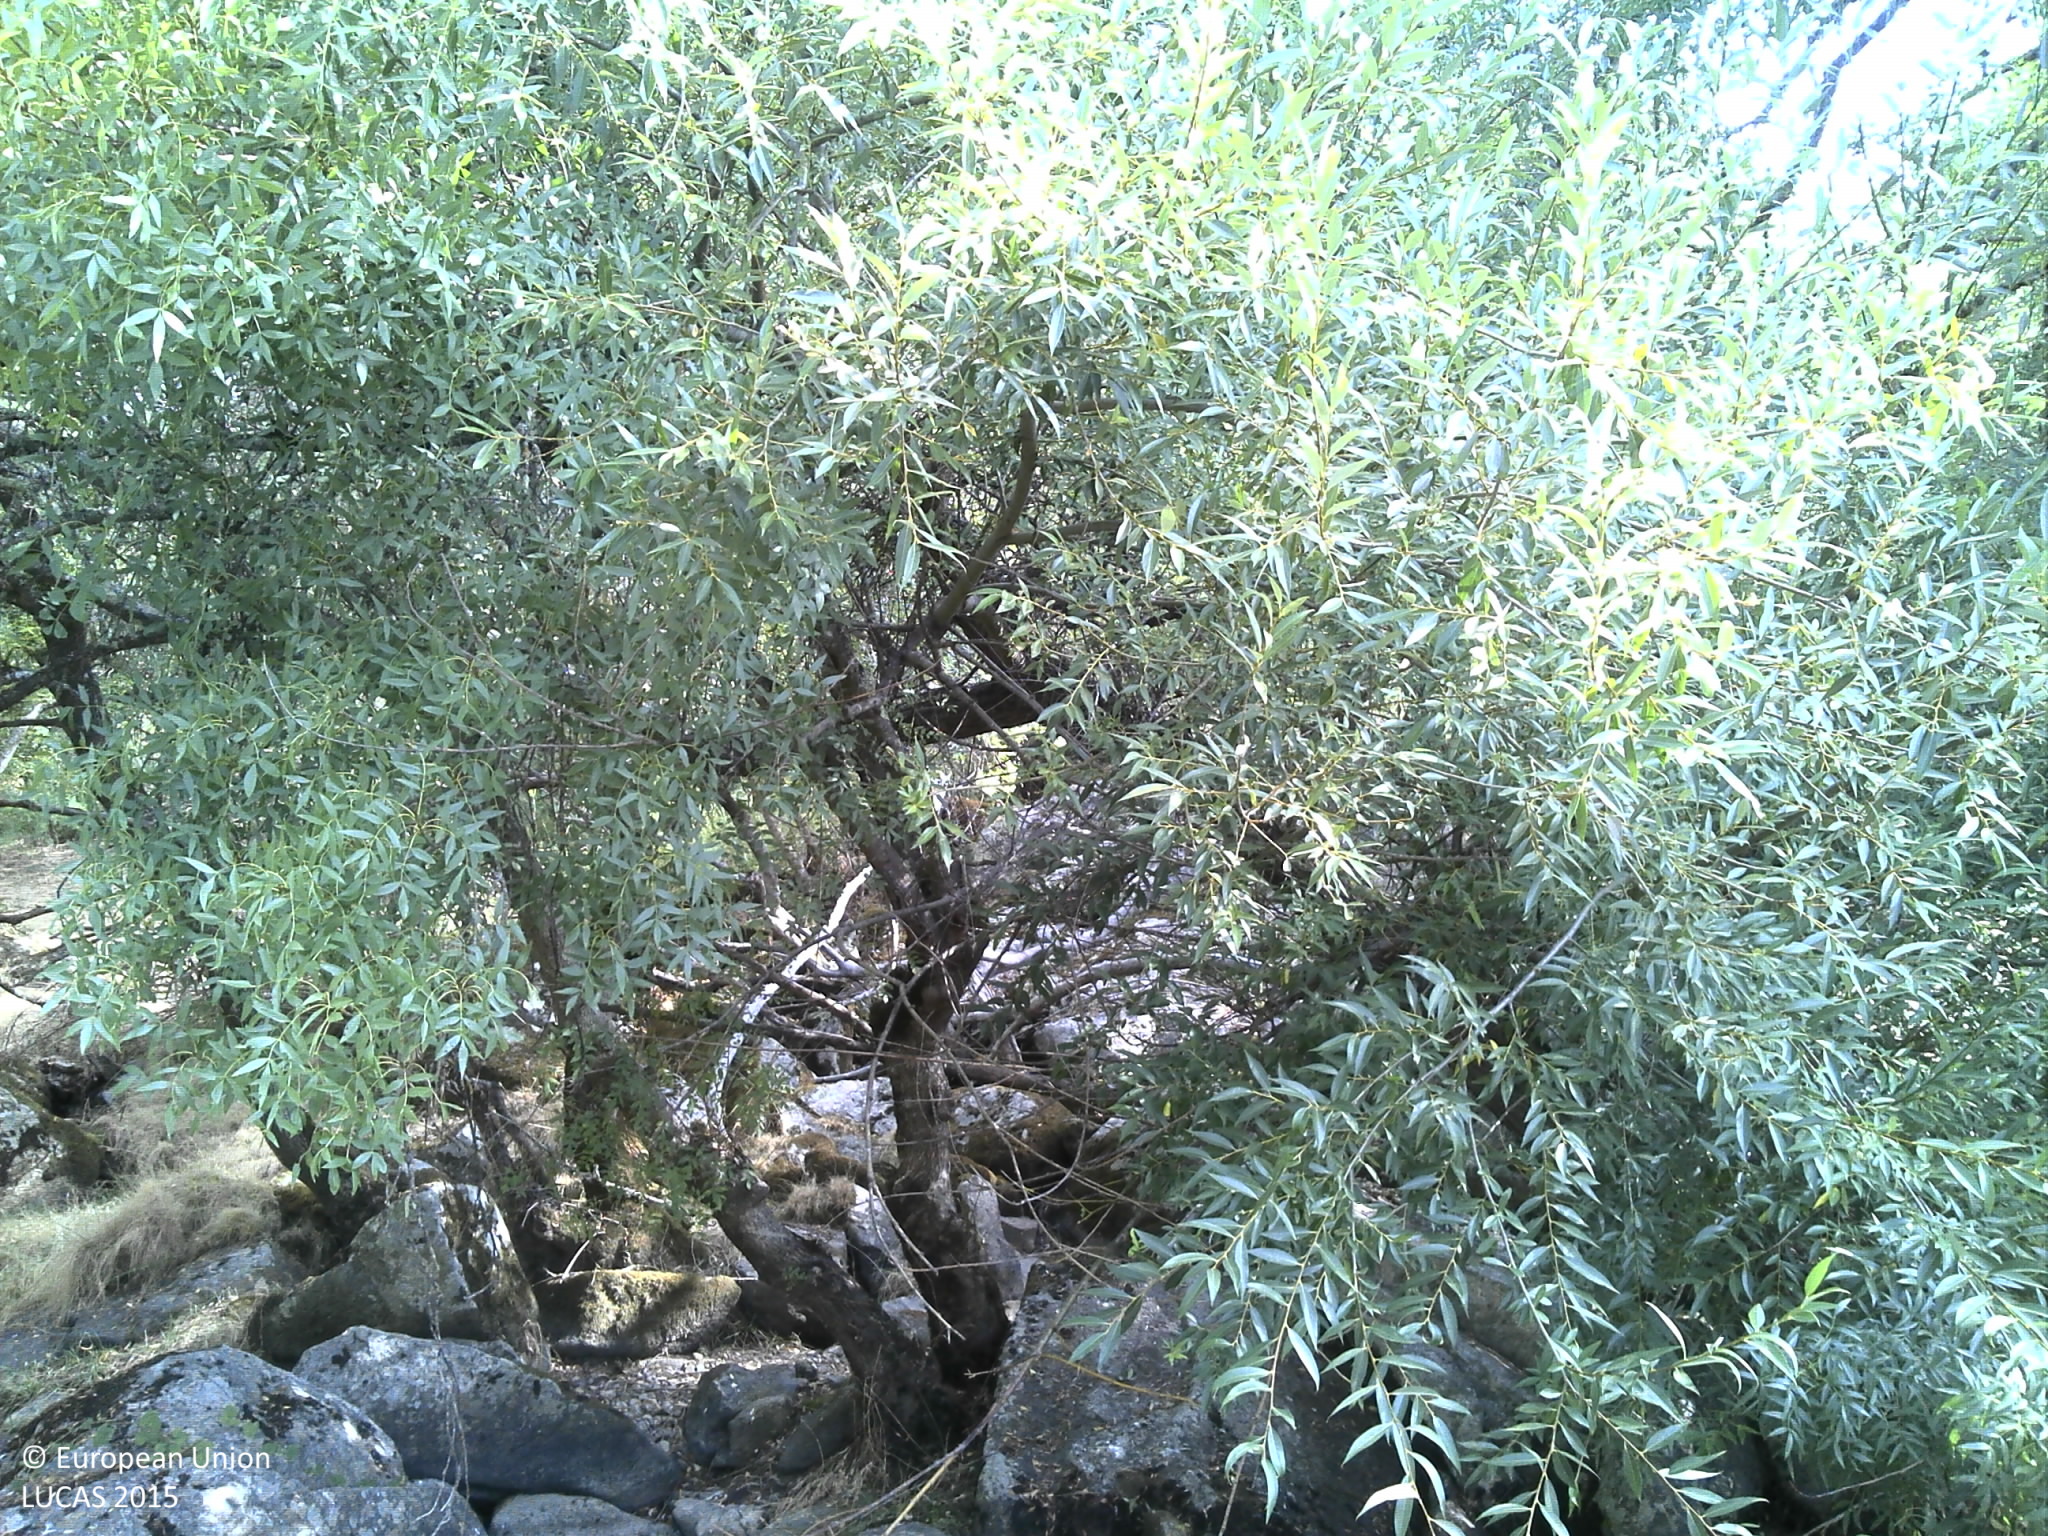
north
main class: Woodland
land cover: Broadleaved woodland
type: broadleaved evergreen forest
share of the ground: > 75 %
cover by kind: broadleaved forest trees 75 %, consolidated bare surface 25 %
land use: Forestry
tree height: > 5 m
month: August
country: PT
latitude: 39.2612
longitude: -7.5555
